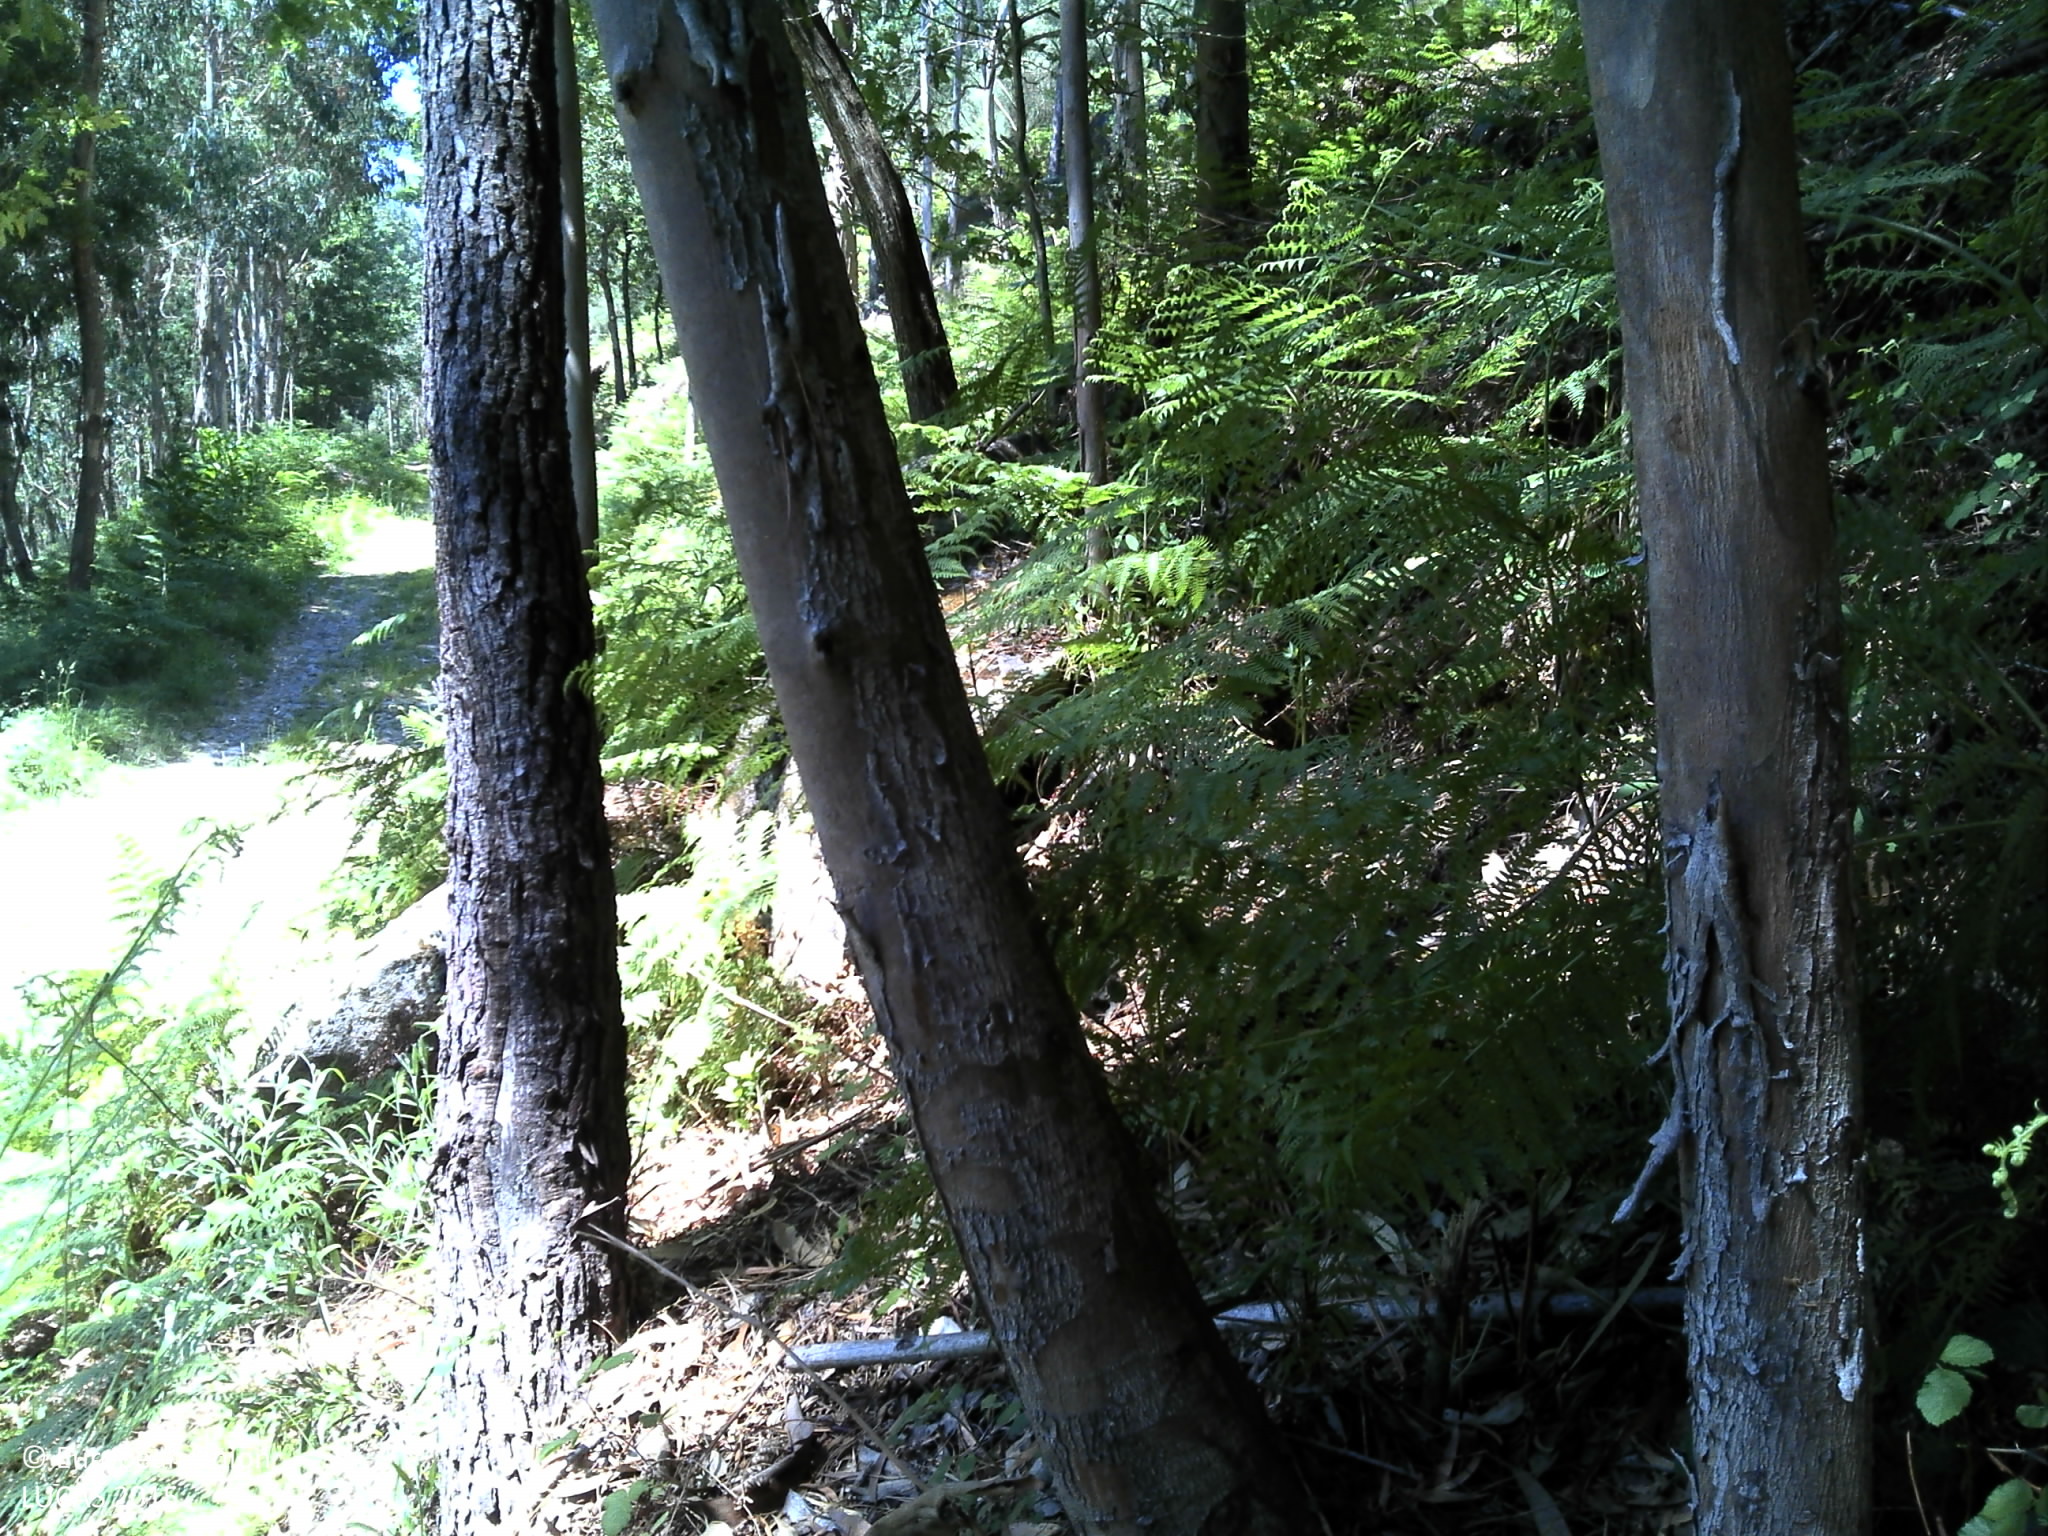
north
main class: Woodland
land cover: Broadleaved woodland
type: exotic forest
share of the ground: 50 - 75 %
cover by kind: broadleaved forest trees 50 %, shrubs 25 %, unconsolidated bare surface 25 %
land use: Forestry
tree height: > 5 m
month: May
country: PT
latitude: 41.7805
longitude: -8.6074
